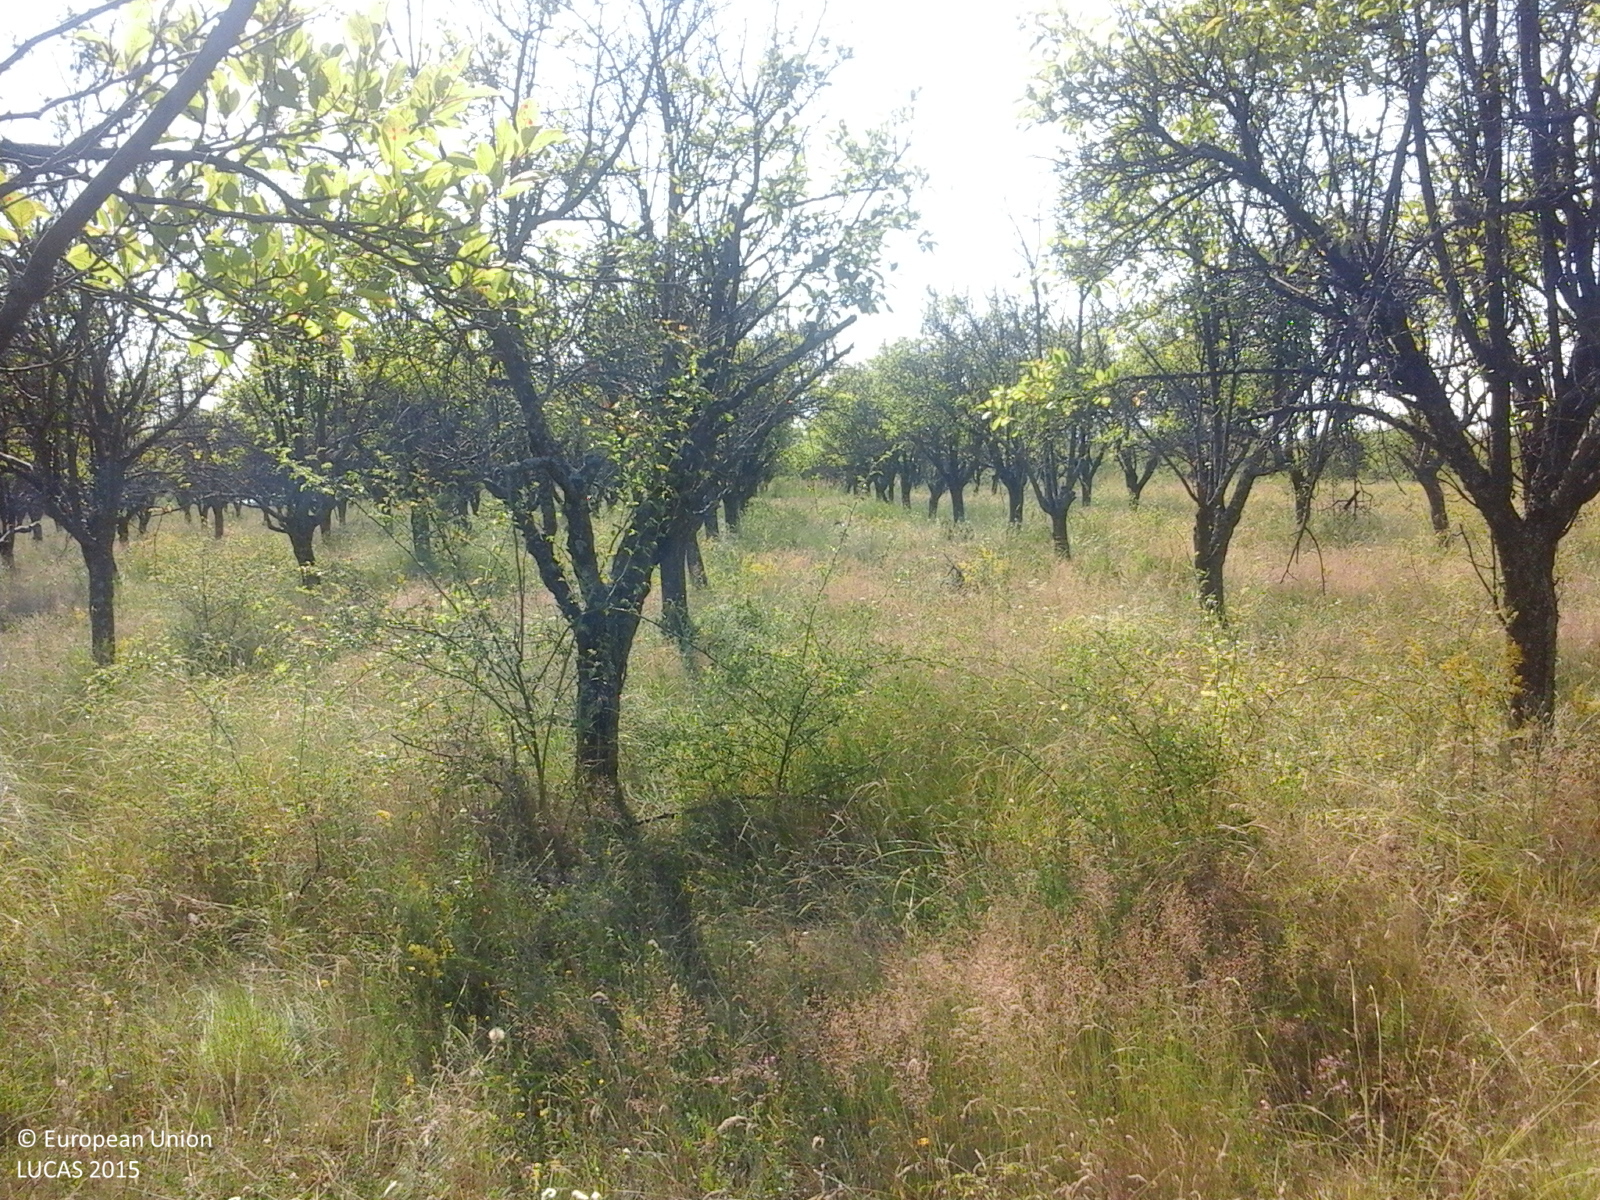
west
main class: Cropland
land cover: Apple fruit
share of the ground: > 75 %
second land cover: Grassland without tree/shrub cover
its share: > 75 %
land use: Agriculture (excluding fallow land and kitchen gardens)
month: July
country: RO
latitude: 44.7446
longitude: 24.6897
